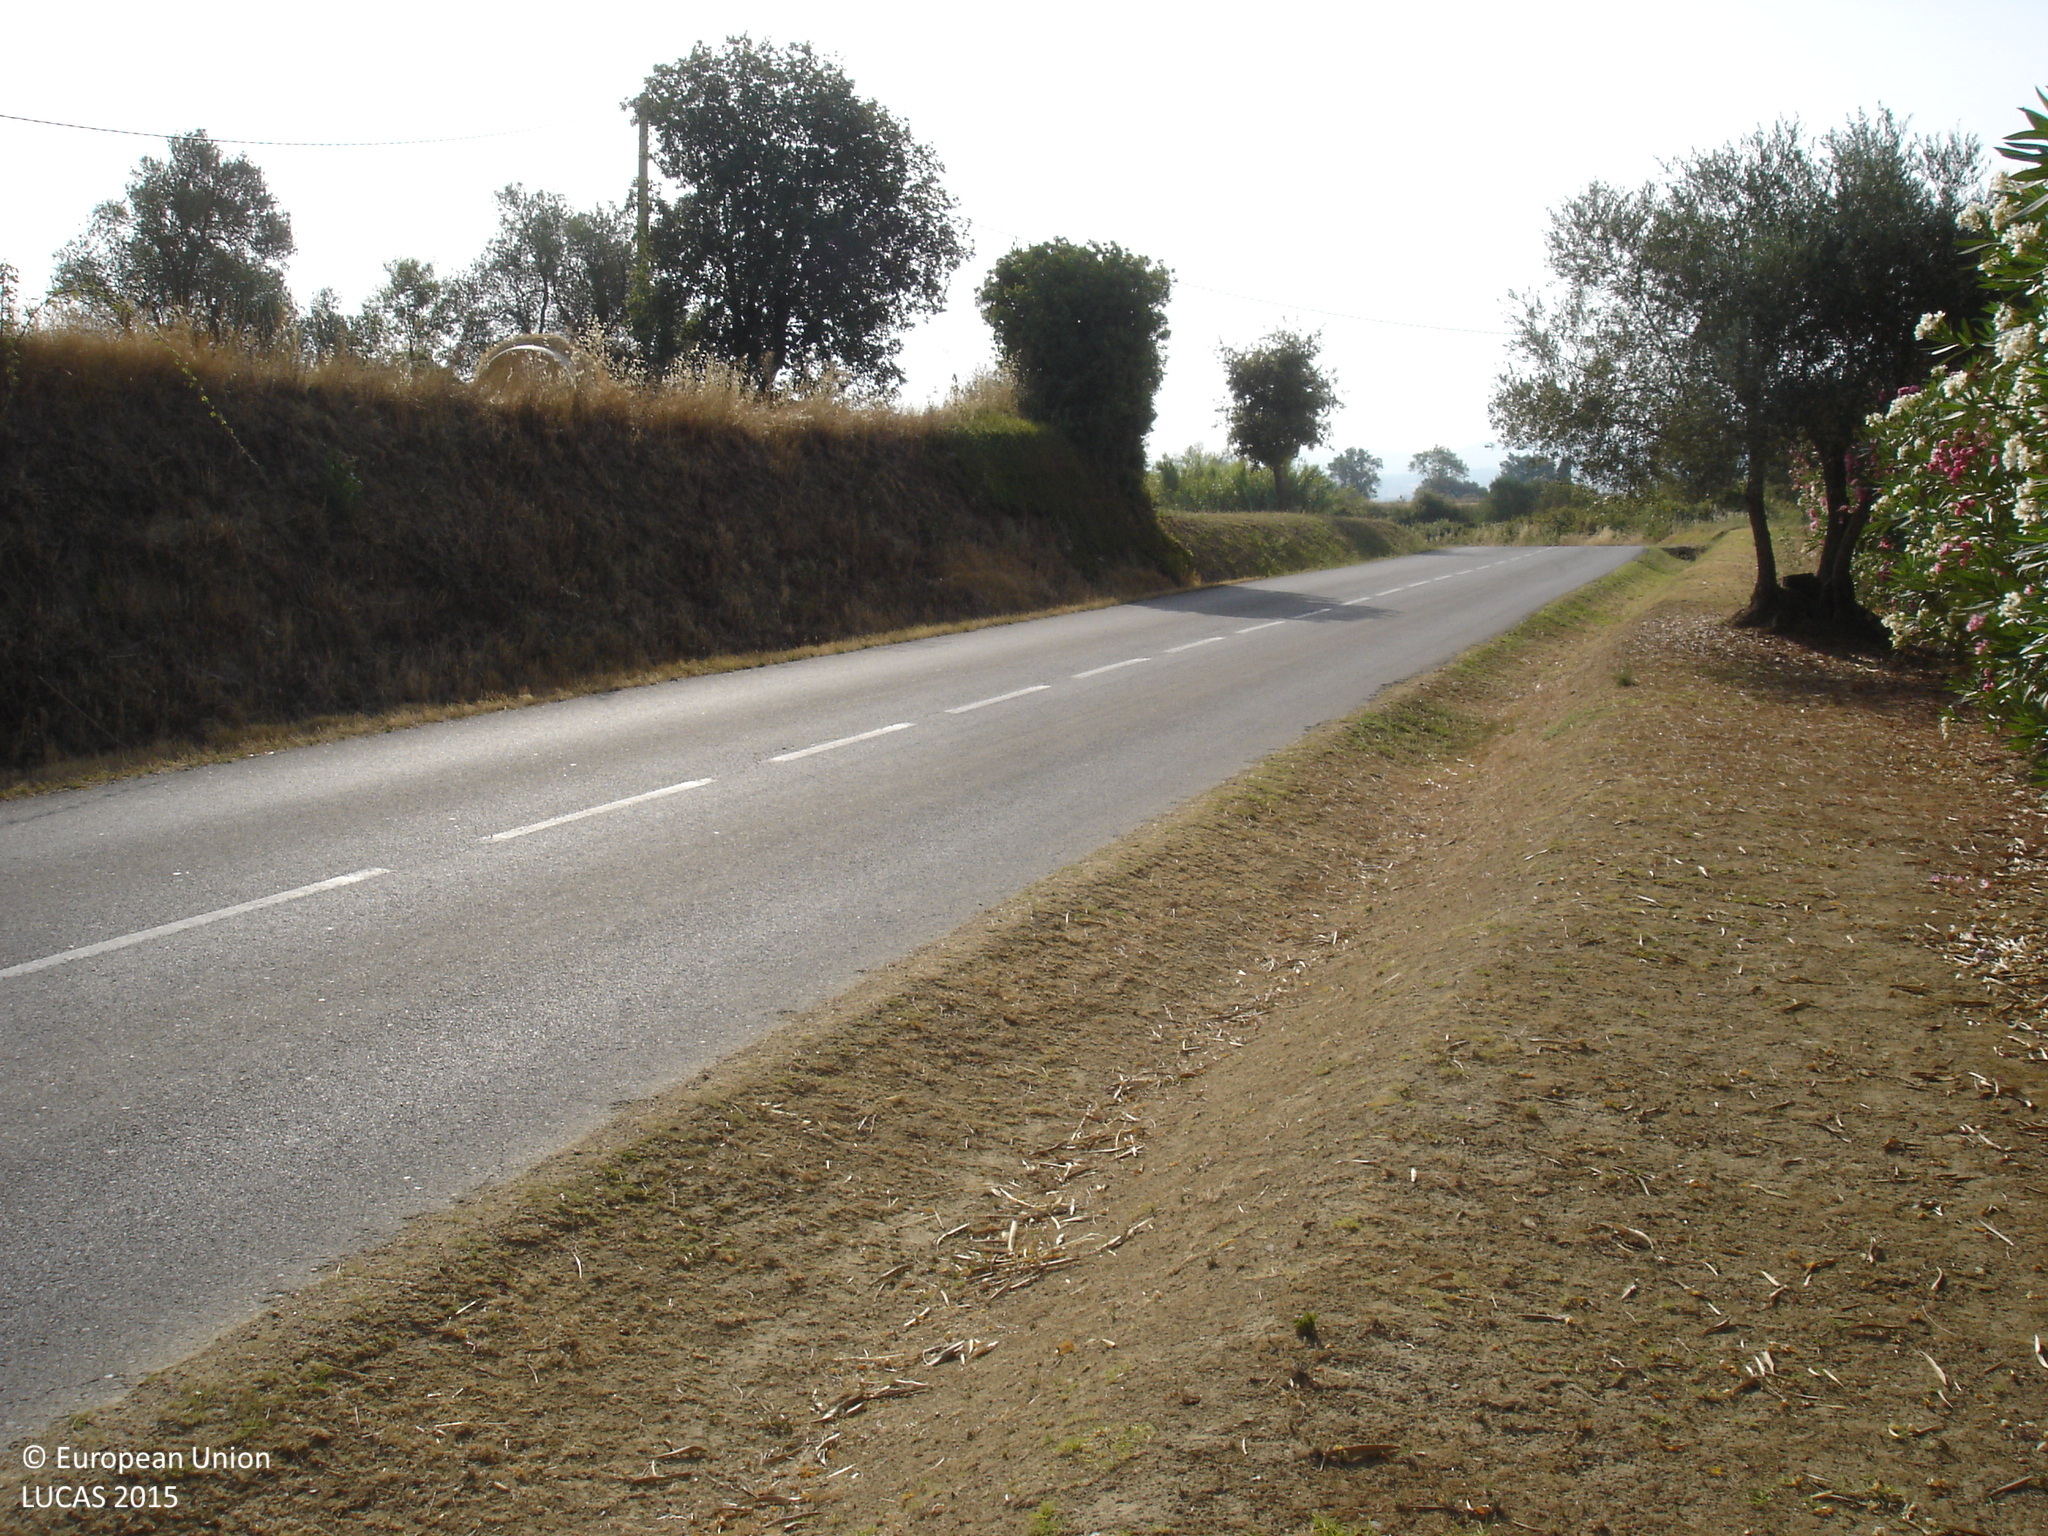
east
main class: Cropland
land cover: Olive groves
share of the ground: 25 - 50 %
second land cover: Other bare soil
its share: > 75 %
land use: Agriculture (excluding fallow land and kitchen gardens)
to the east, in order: Olive groves; Other bare soil; Fences; Grassland with sparse tree/shrub cover; Paved roads, cycling and walking lanes; Grassland with sparse tree/shrub cover; Electric lines; Shrubland with sparse tree cover; Tracks; Shrubland with sparse tree cover; Oats; Grass margins; Paved roads, cycling and walking lanes; Grass margins; Shruby margins; Oats; Shrubland with sparse tree cover; Oats; Grass margins; Paved roads, cycling and walking lanes; Grass margins; Lucerne
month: July
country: ES
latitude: 41.9590
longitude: 3.0061
